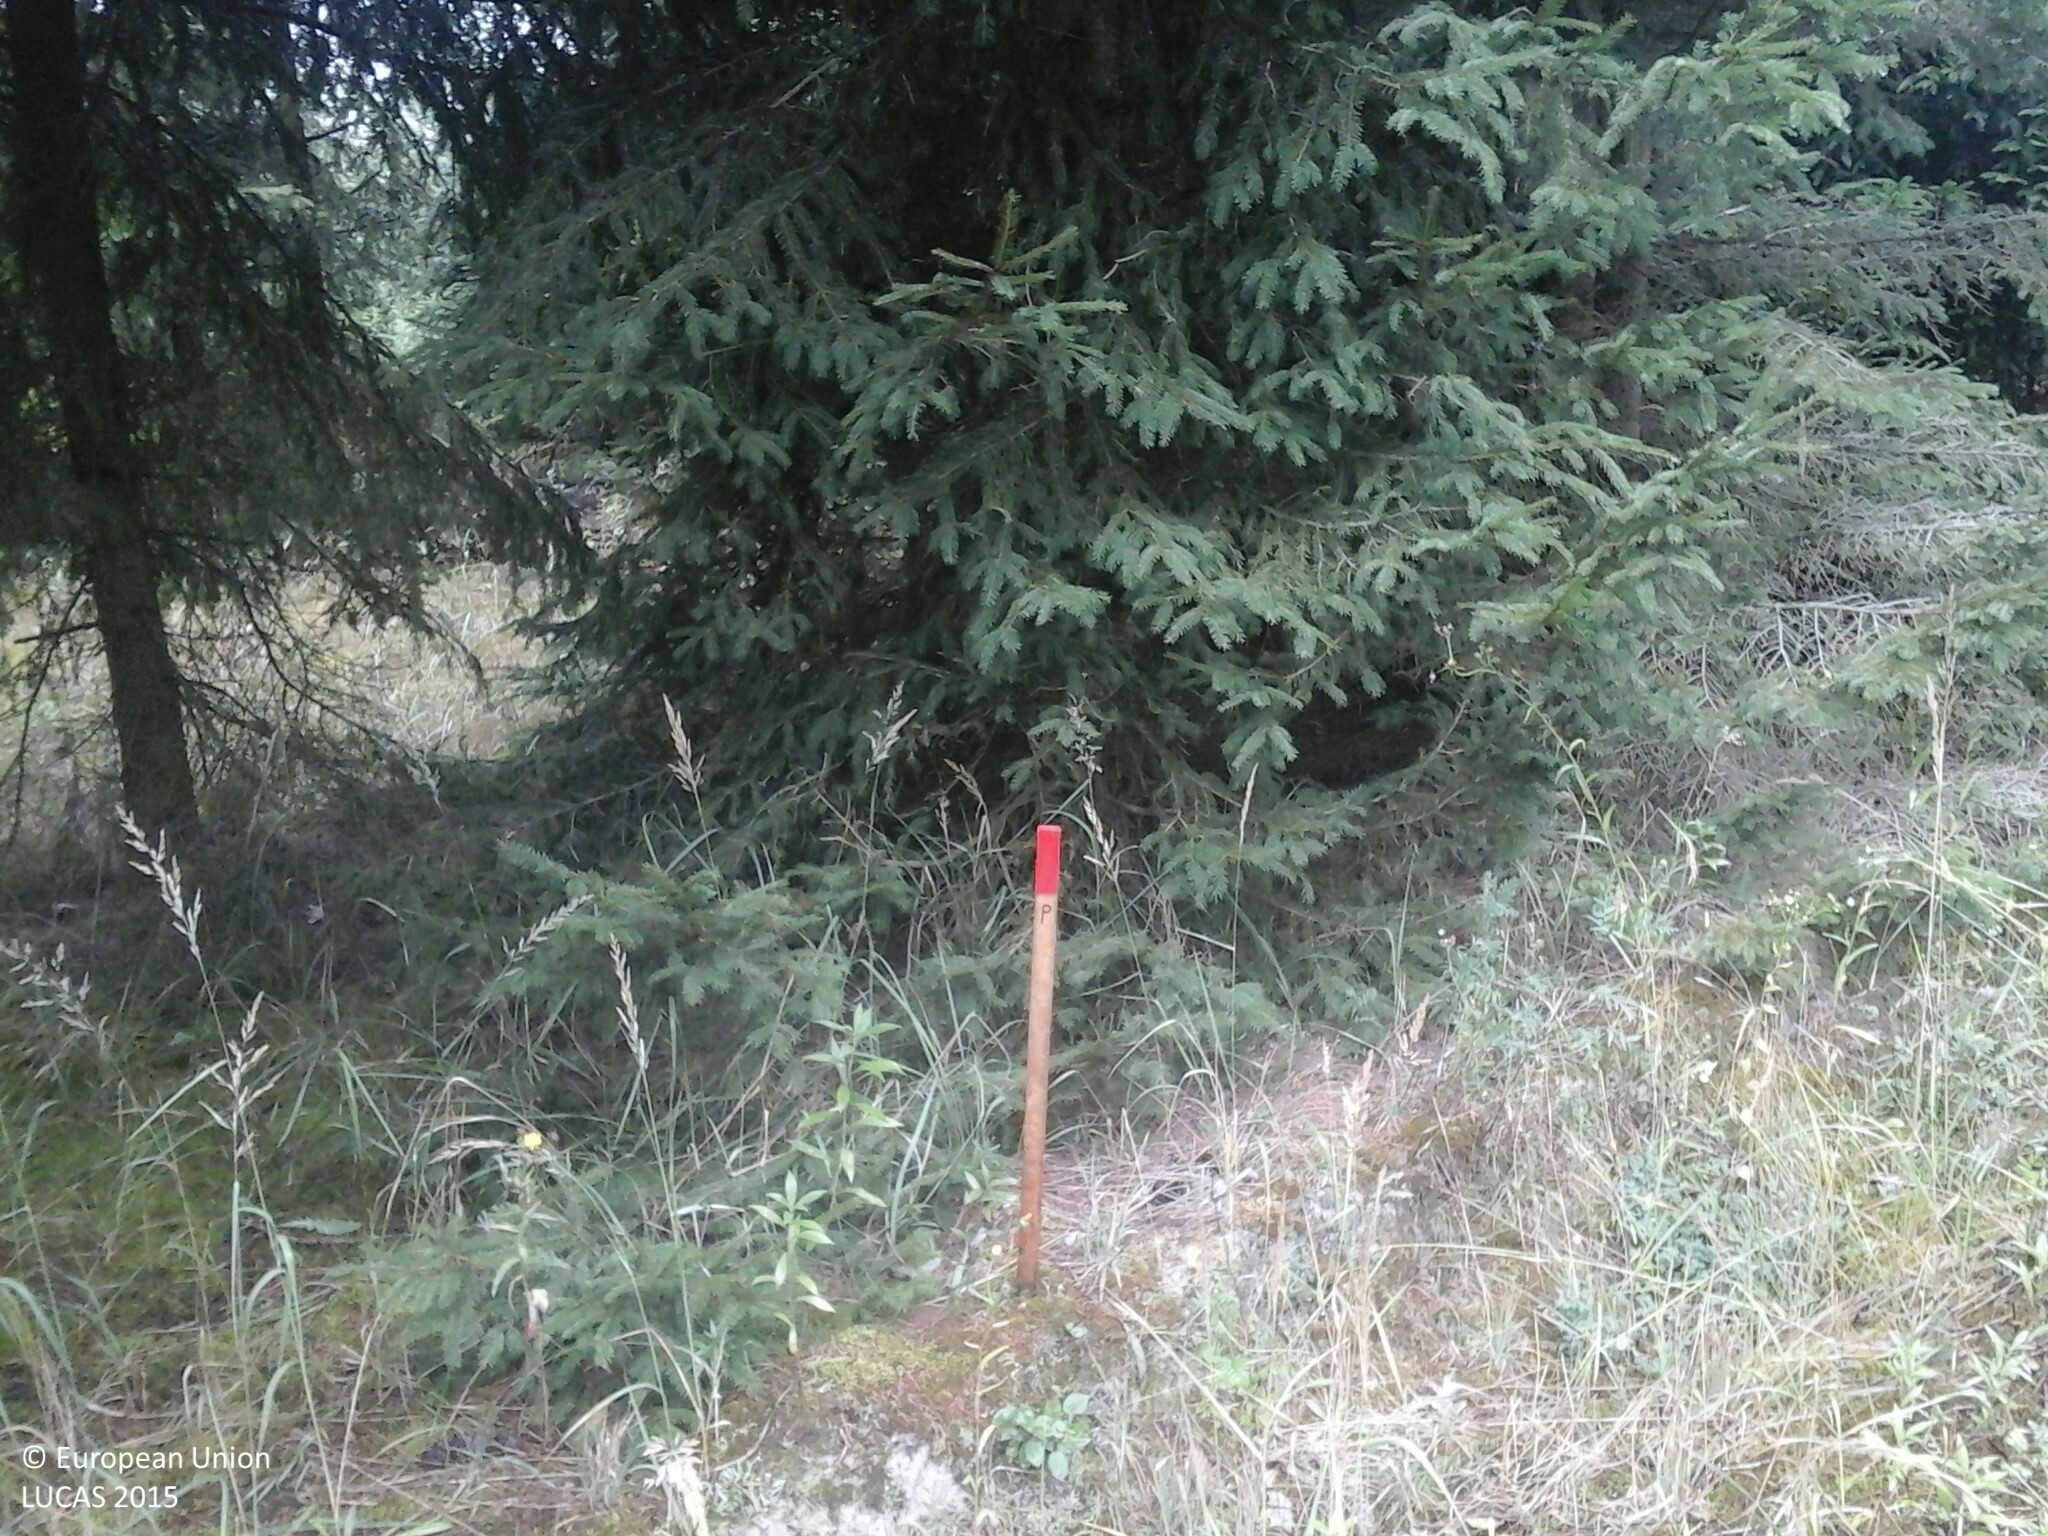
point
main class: Woodland
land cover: Spruce dominated coniferous woodland
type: hemiboreal forest and nemoral coniferous forest and mixed broadleaved-coniferous forest
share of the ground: > 75 %
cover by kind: coniferous forest trees 80 %, herbaceous plants 20 %
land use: Forestry
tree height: > 5 m
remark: Nursery
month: July
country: HU
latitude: 46.8583
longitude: 16.4948
